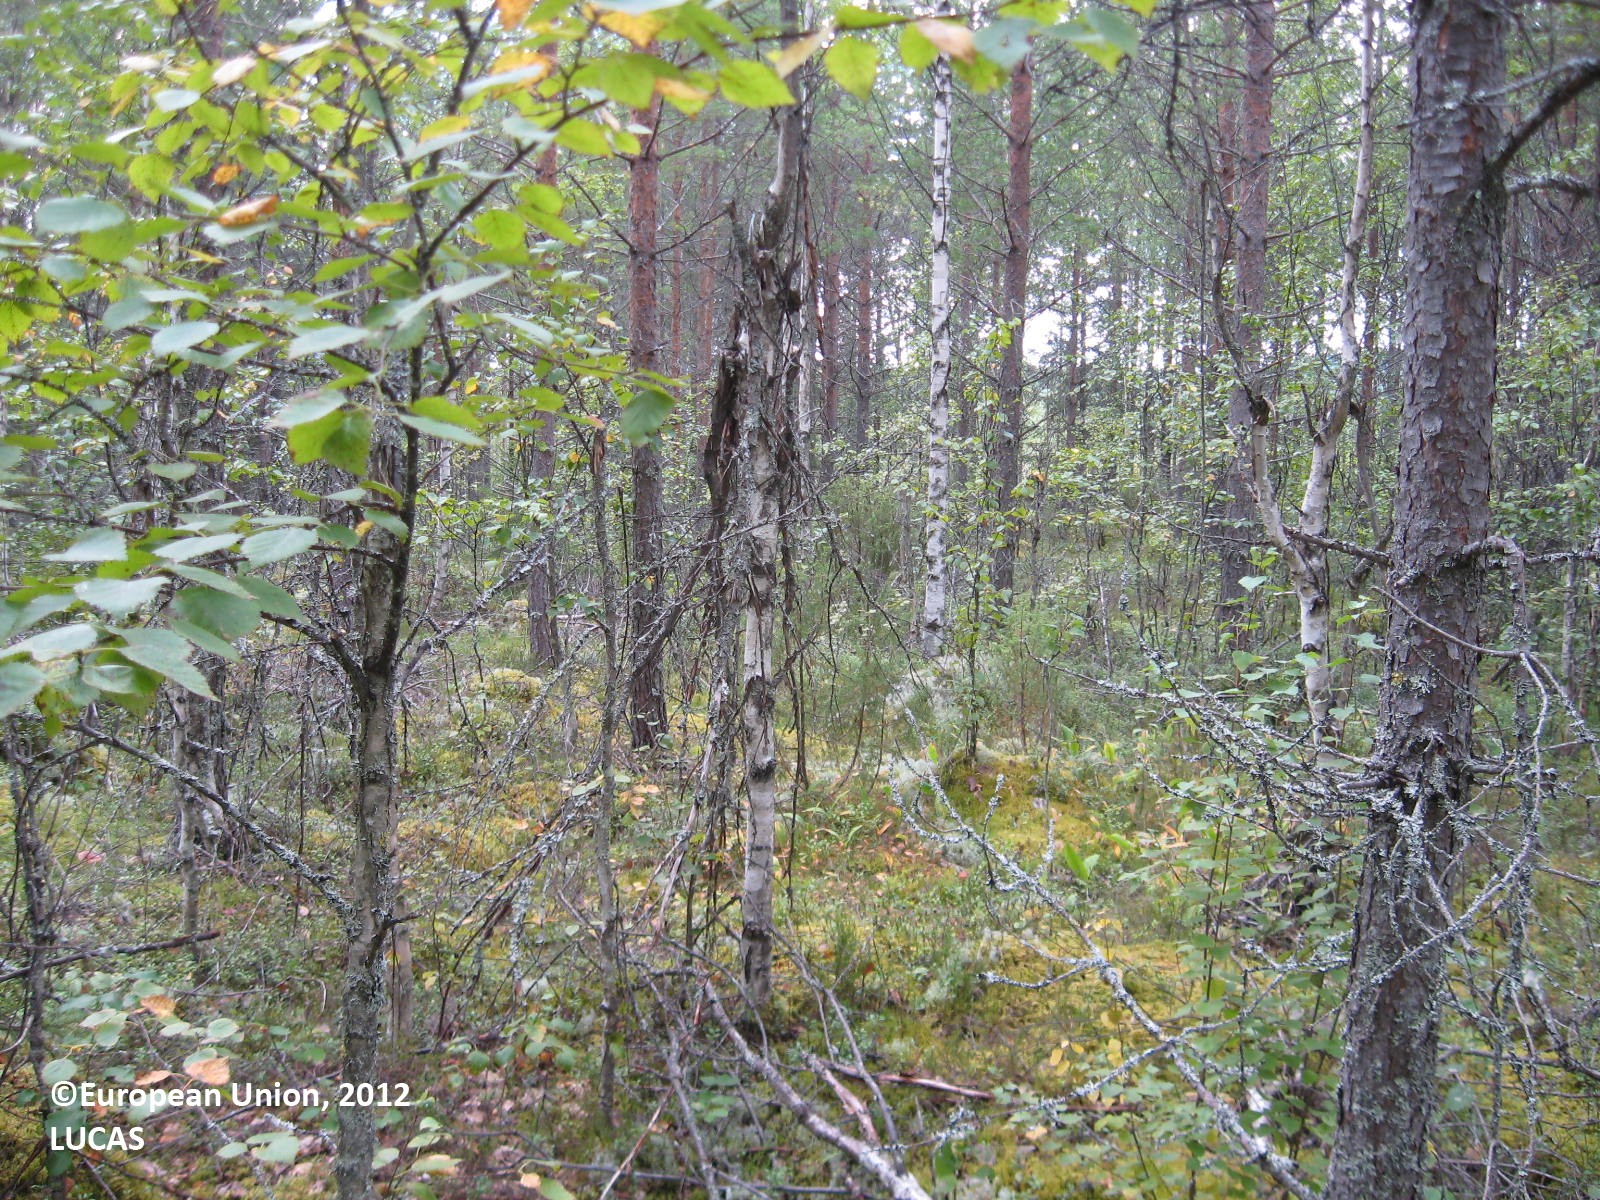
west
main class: Woodland
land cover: Pine dominated mixed woodland
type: boreal forest
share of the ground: > 75 %
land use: Forestry
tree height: > 5 m
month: August
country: FI
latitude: 63.3924
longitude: 30.2110
